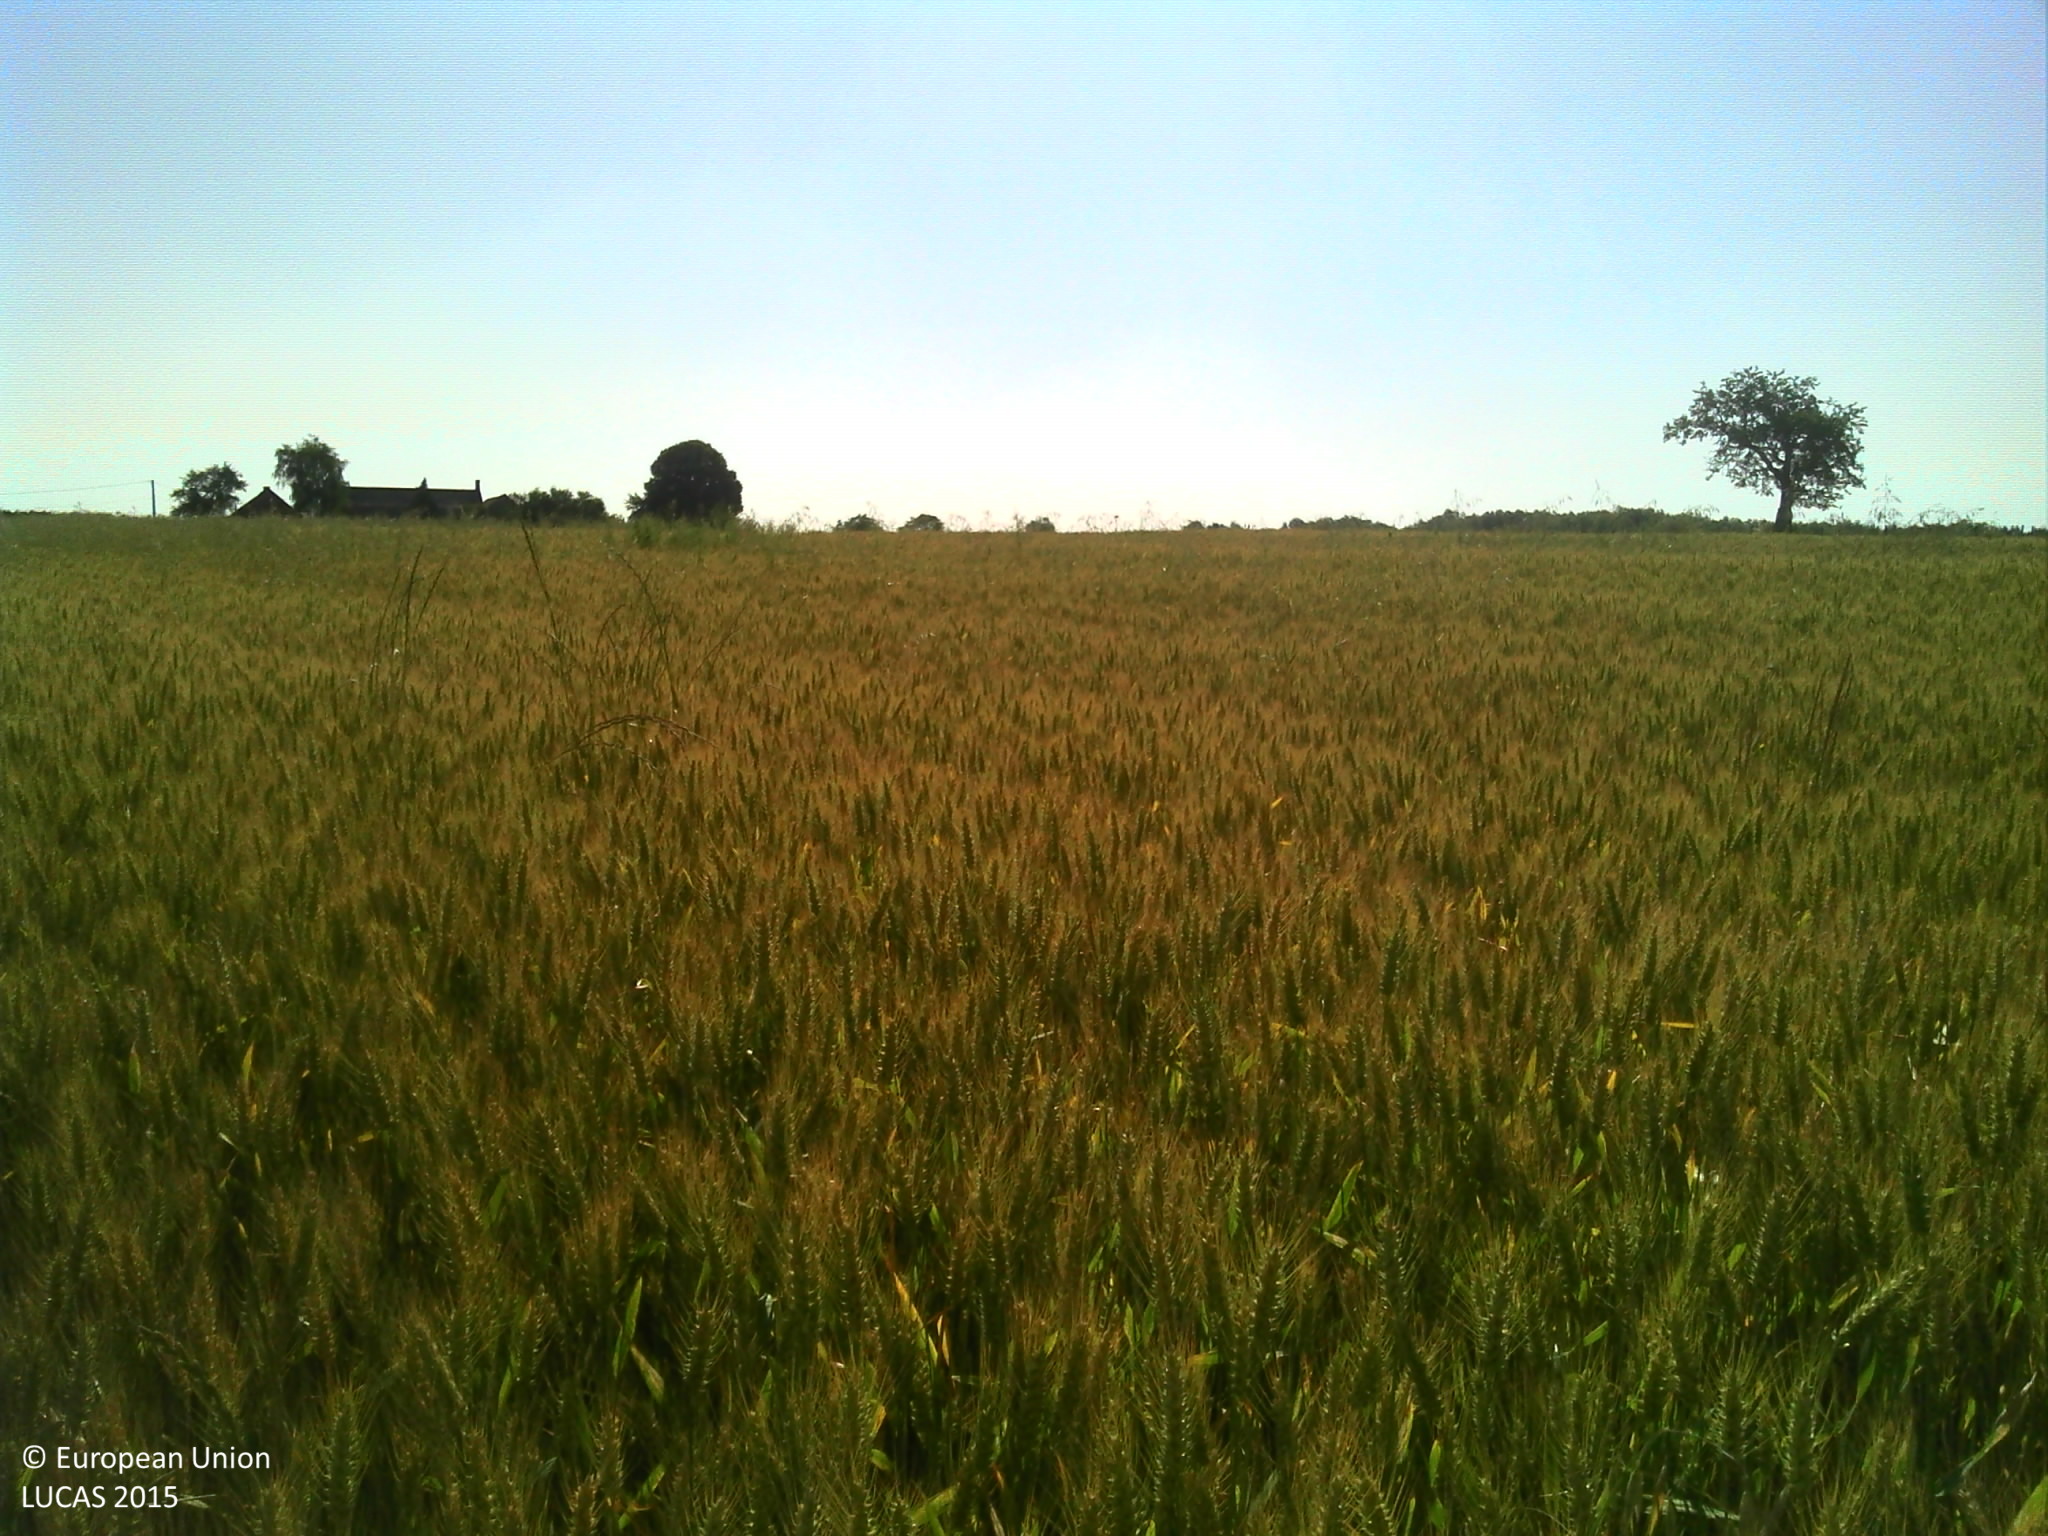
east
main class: Cropland
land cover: Durum wheat
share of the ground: > 75 %
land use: Agriculture (excluding fallow land and kitchen gardens)
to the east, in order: Durum wheat; Sunflower; Fences; Grass margins; Tracks; Grass margins; Fences; Sunflower
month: June
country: FR
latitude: 47.5032
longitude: 0.4861
